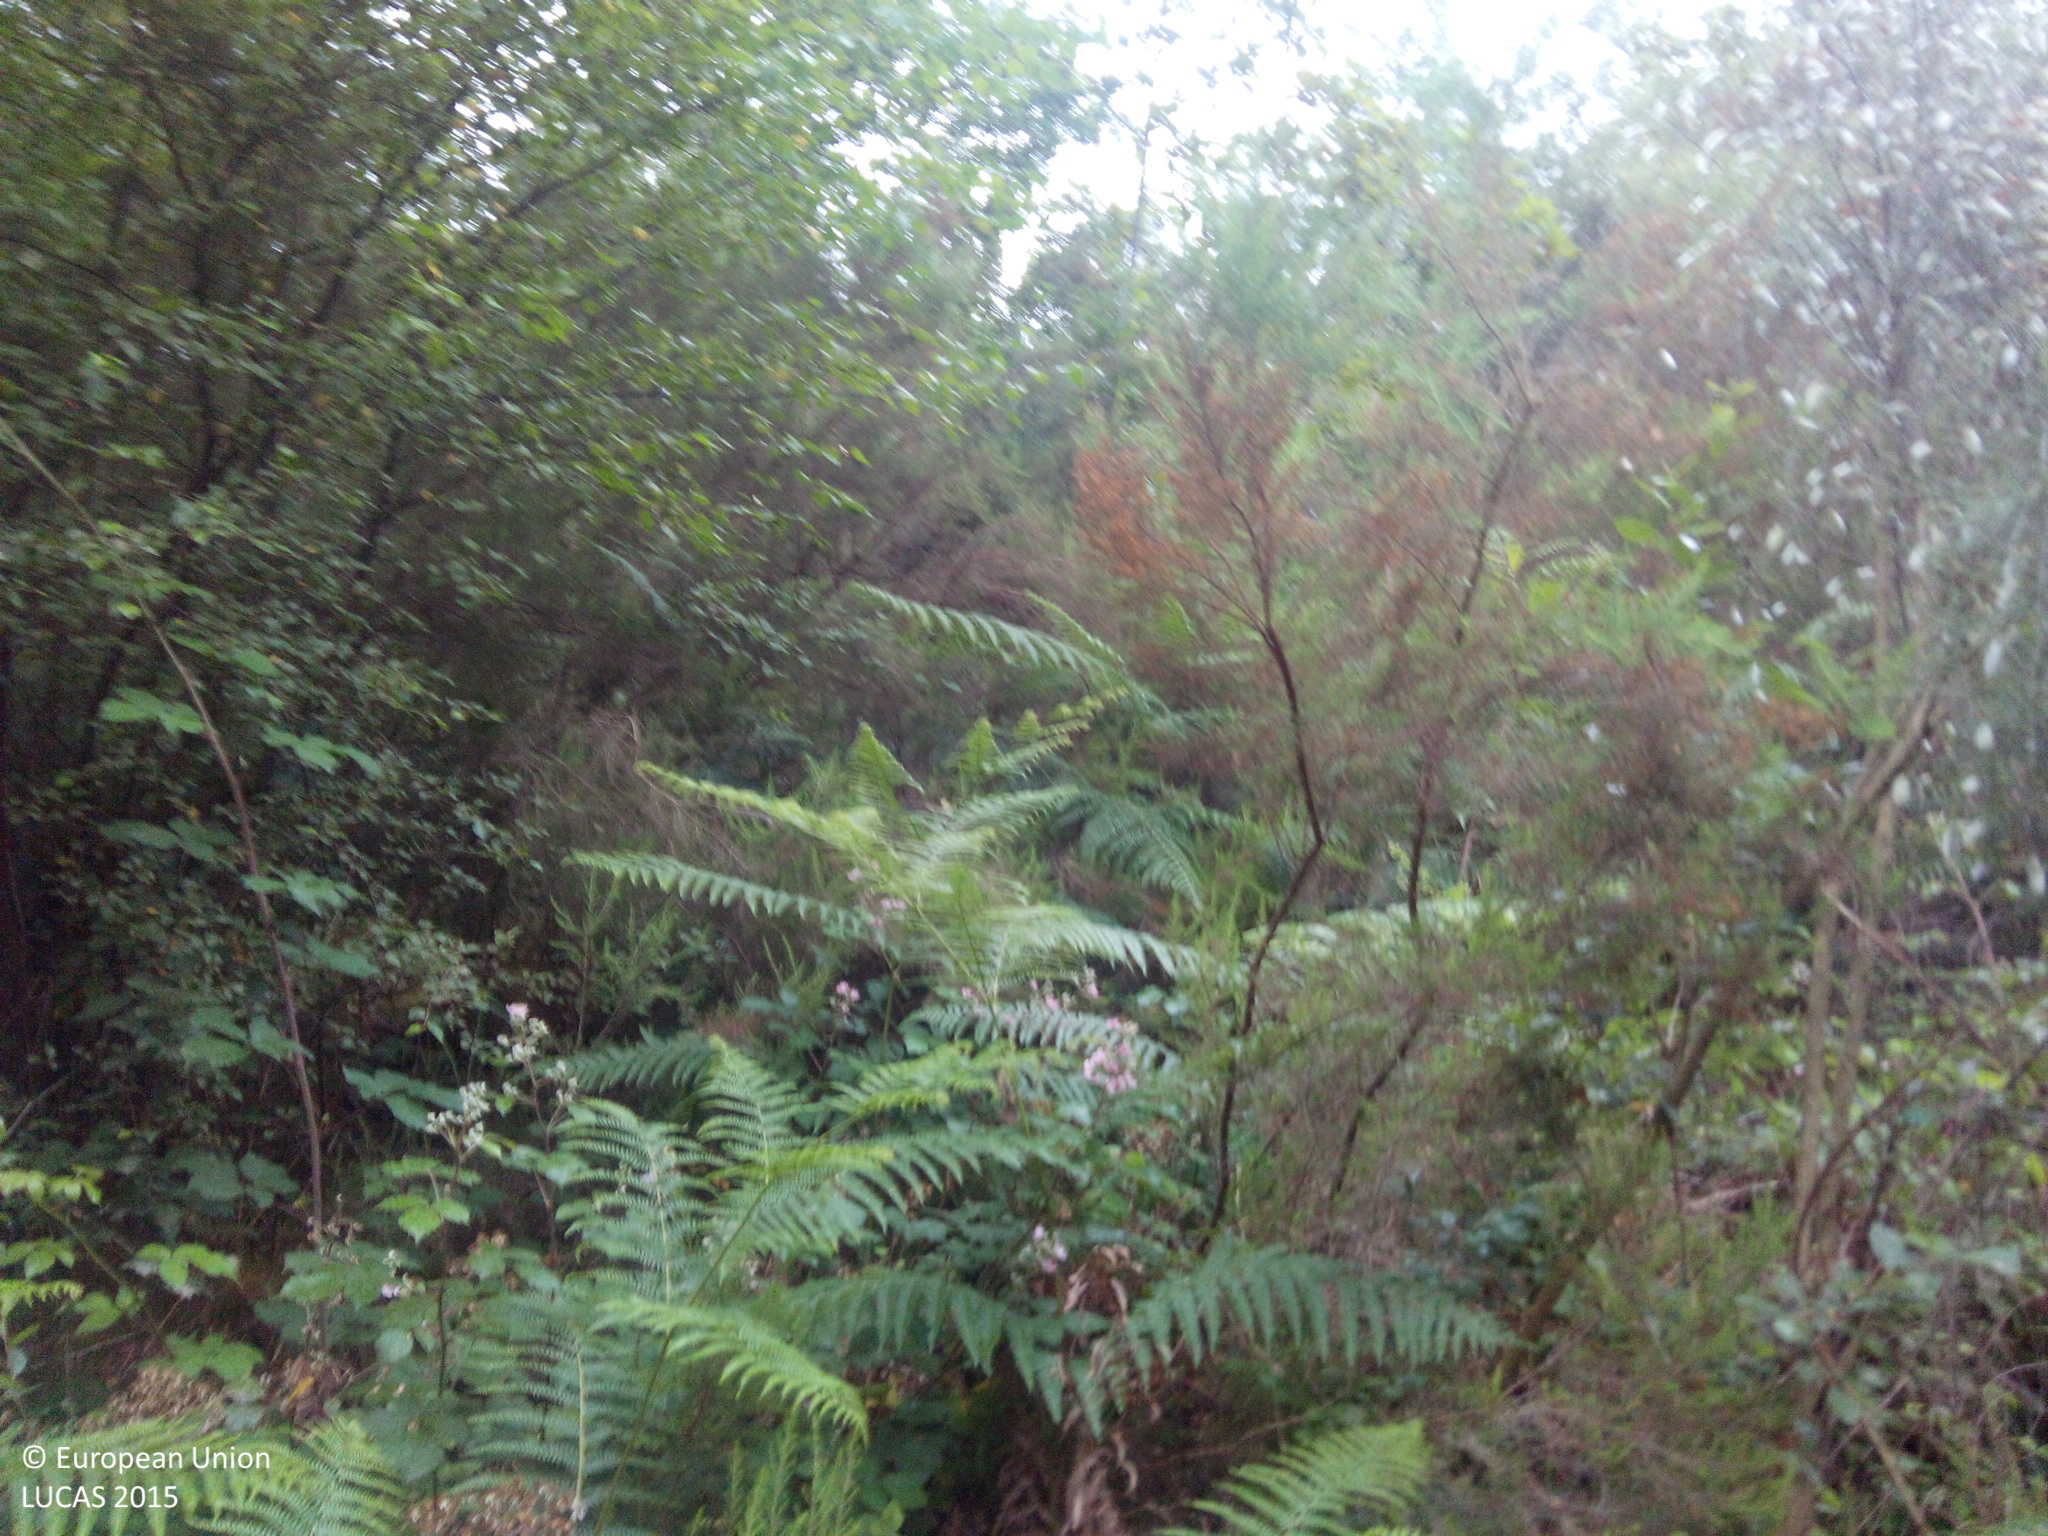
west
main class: Shrubland
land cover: Shrubland with sparse tree cover
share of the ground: > 75 %
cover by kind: shrubs 95 %, coniferous forest trees 5 %
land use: Forestry
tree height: > 5 m
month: July
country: ES
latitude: 42.2655
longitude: -8.2854
